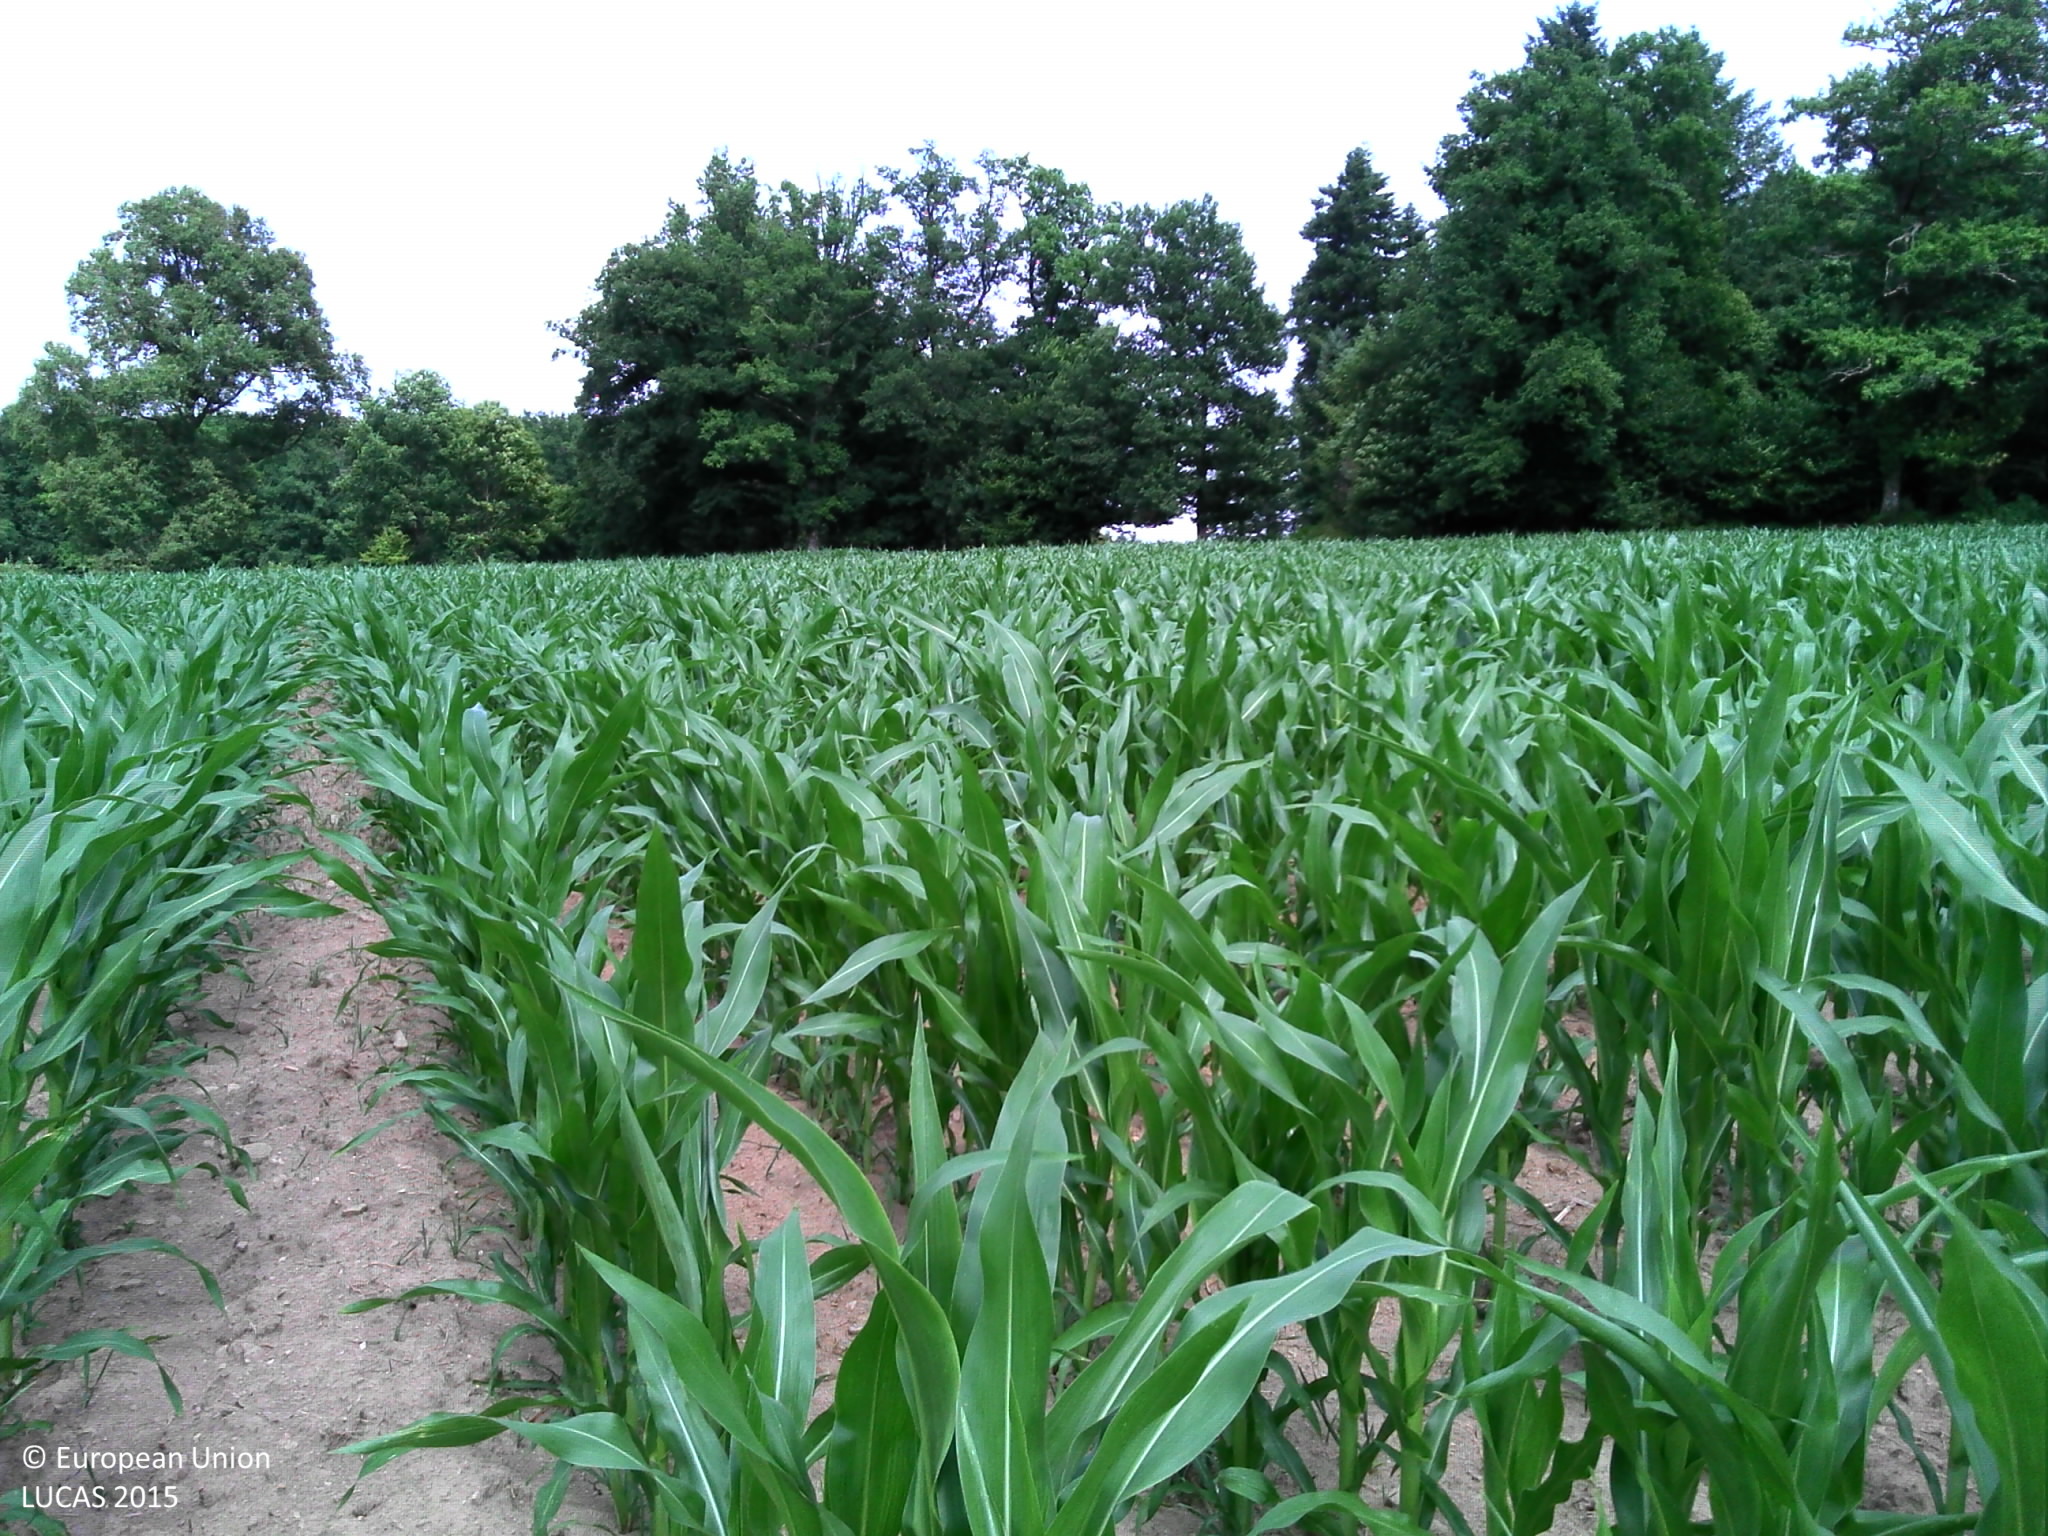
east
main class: Cropland
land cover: Maize
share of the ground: > 75 %
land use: Agriculture (excluding fallow land and kitchen gardens)
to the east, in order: Maize; Fences; Grassland without tree/shrub cover; Lines of trees; Fences; Grassland without tree/shrub cover; Spontaneously vegetated surfaces; Fences; Spruce dominated coniferous woodland; Broadleaved woodland; Fences; Grassland without tree/shrub cover
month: July
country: FR
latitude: 45.7252
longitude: 0.6717
